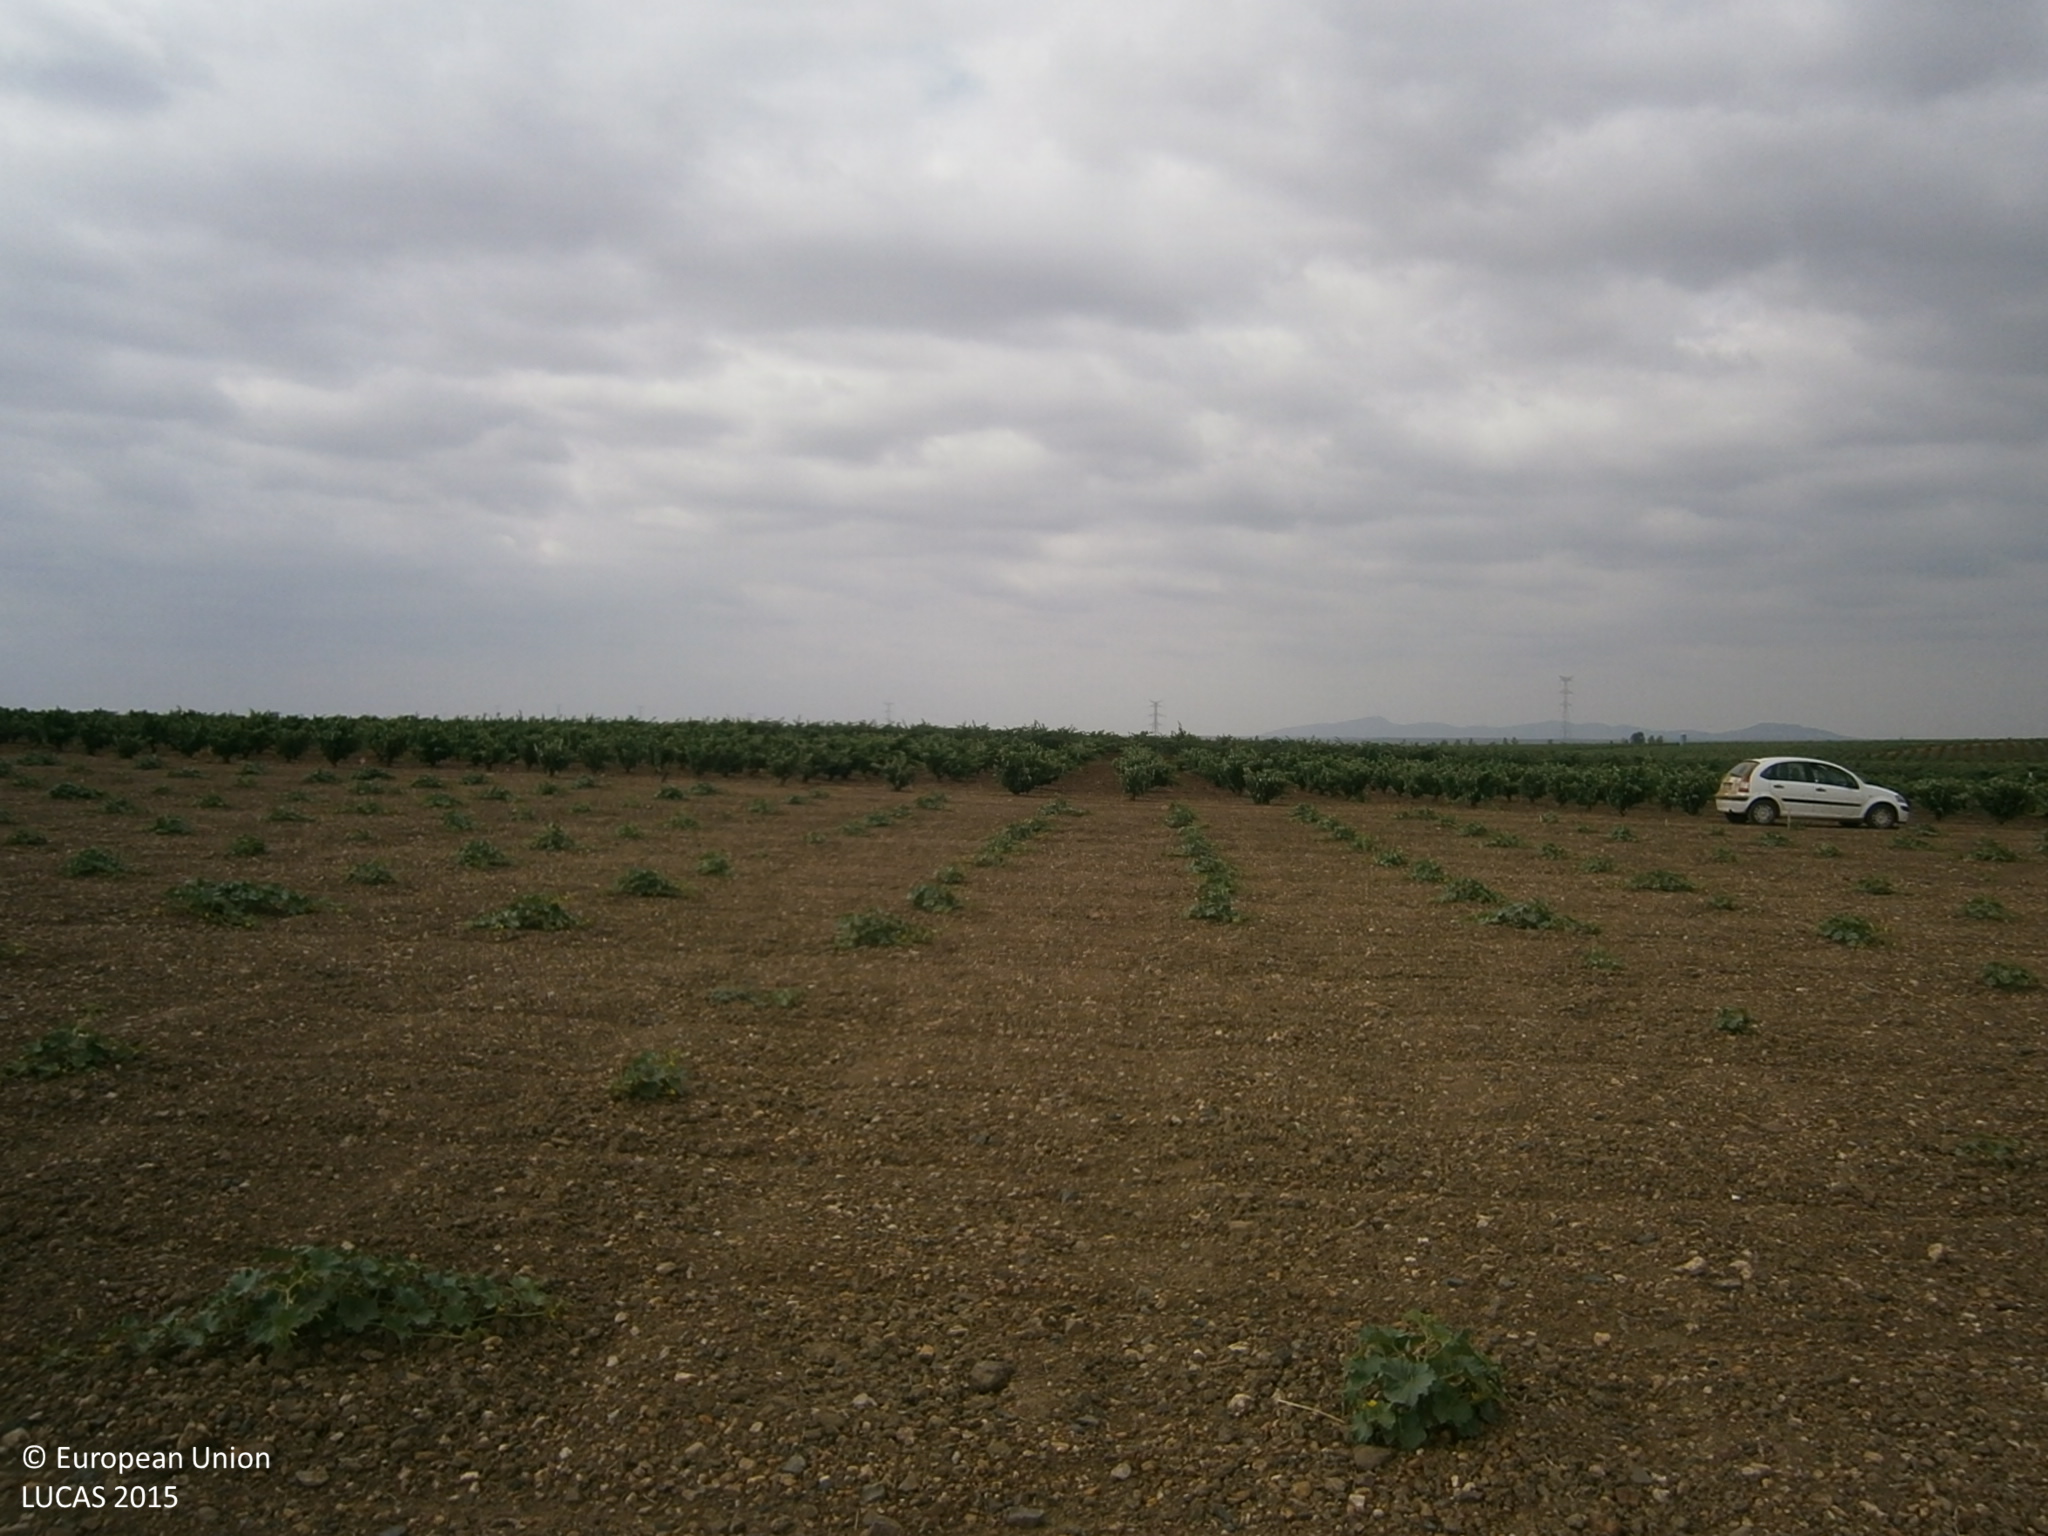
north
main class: Cropland
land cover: Other fresh vegetables
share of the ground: 10 - 25 %
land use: Agriculture (excluding fallow land and kitchen gardens)
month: June
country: ES
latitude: 38.6605
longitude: -6.4778
